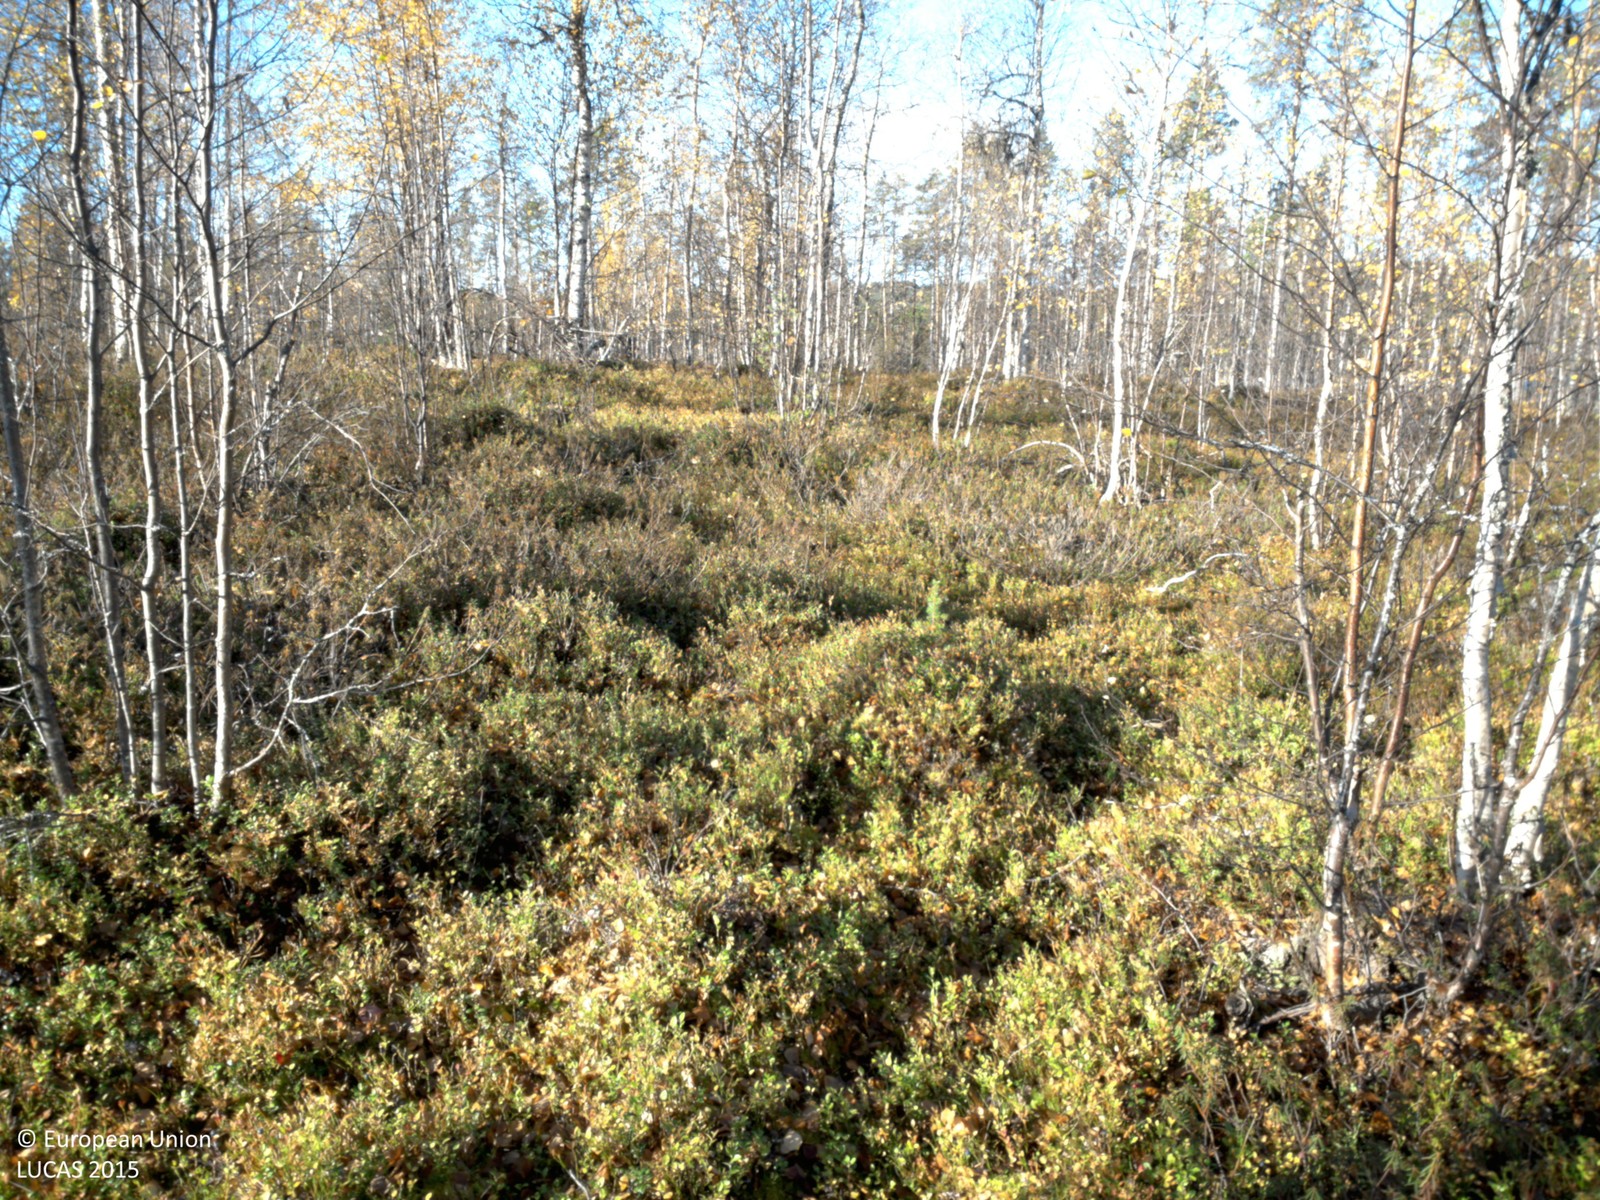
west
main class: Woodland
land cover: Broadleaved woodland
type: hemiboreal forest and nemoral coniferous forest and mixed broadleaved-coniferous forest
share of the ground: 50 - 75 %
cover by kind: broadleaved forest trees 50 %, shrubs 40 %, coniferous forest trees 5 %, lichens and mosses 5 %
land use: Forestry
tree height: > 5 m
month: September
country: SE
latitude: 64.8405
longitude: 18.5457
